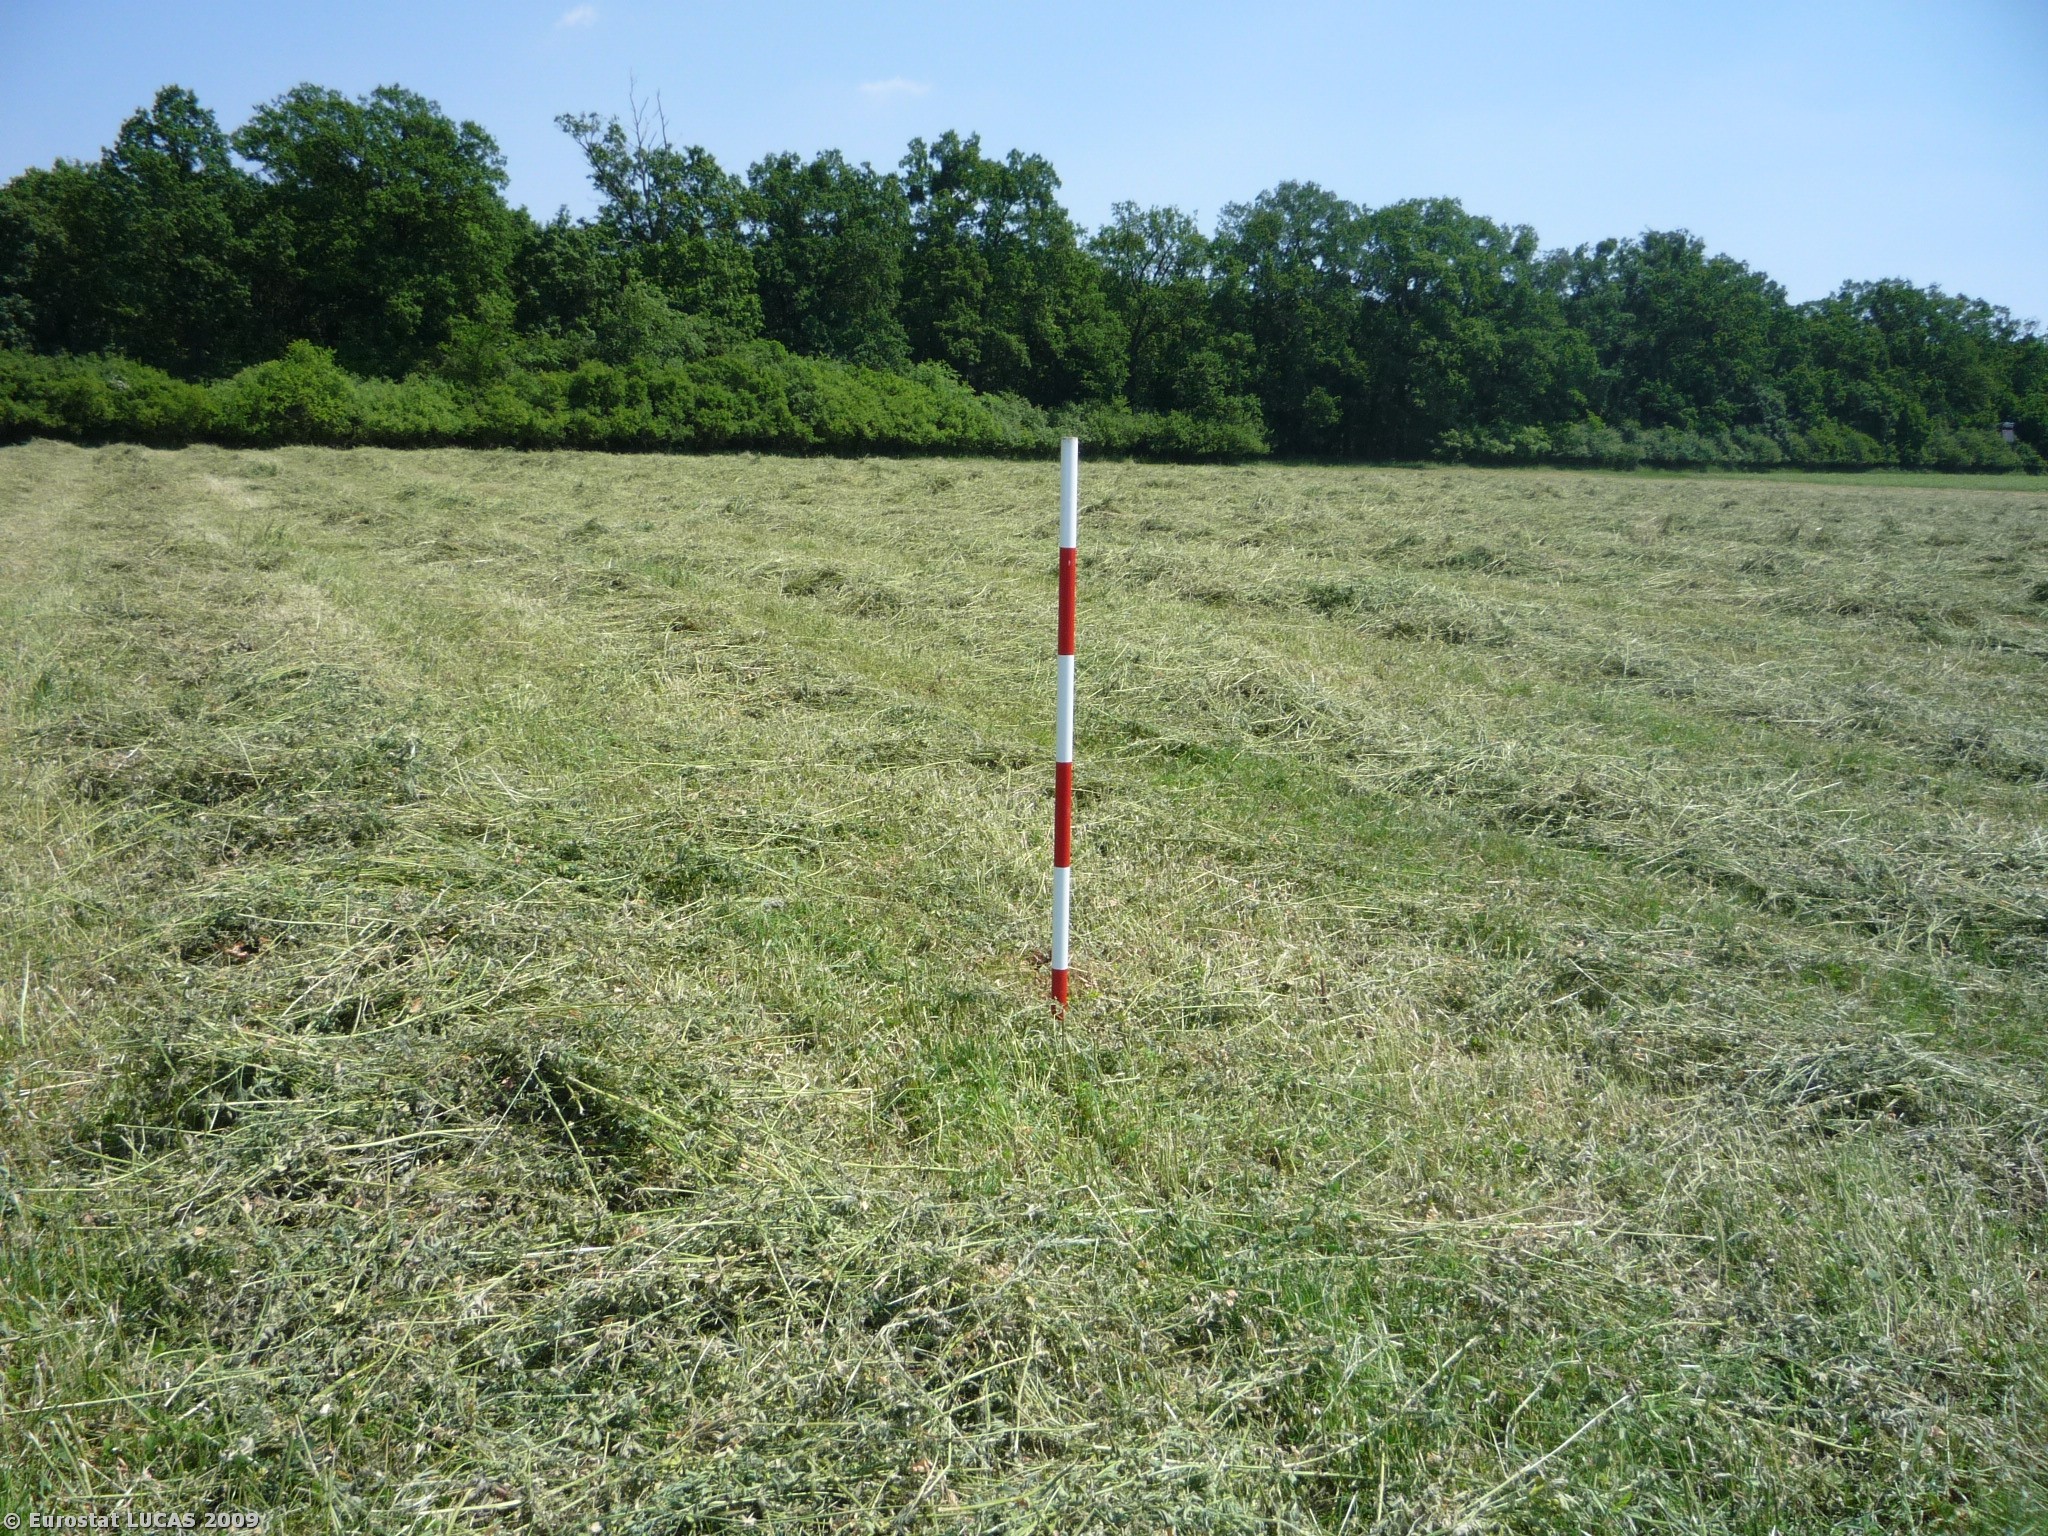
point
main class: Cropland
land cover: Lucerne
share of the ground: > 75 %
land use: Agriculture (excluding fallow land and kitchen gardens)
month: May
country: CZ
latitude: 50.2670
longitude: 15.5176
